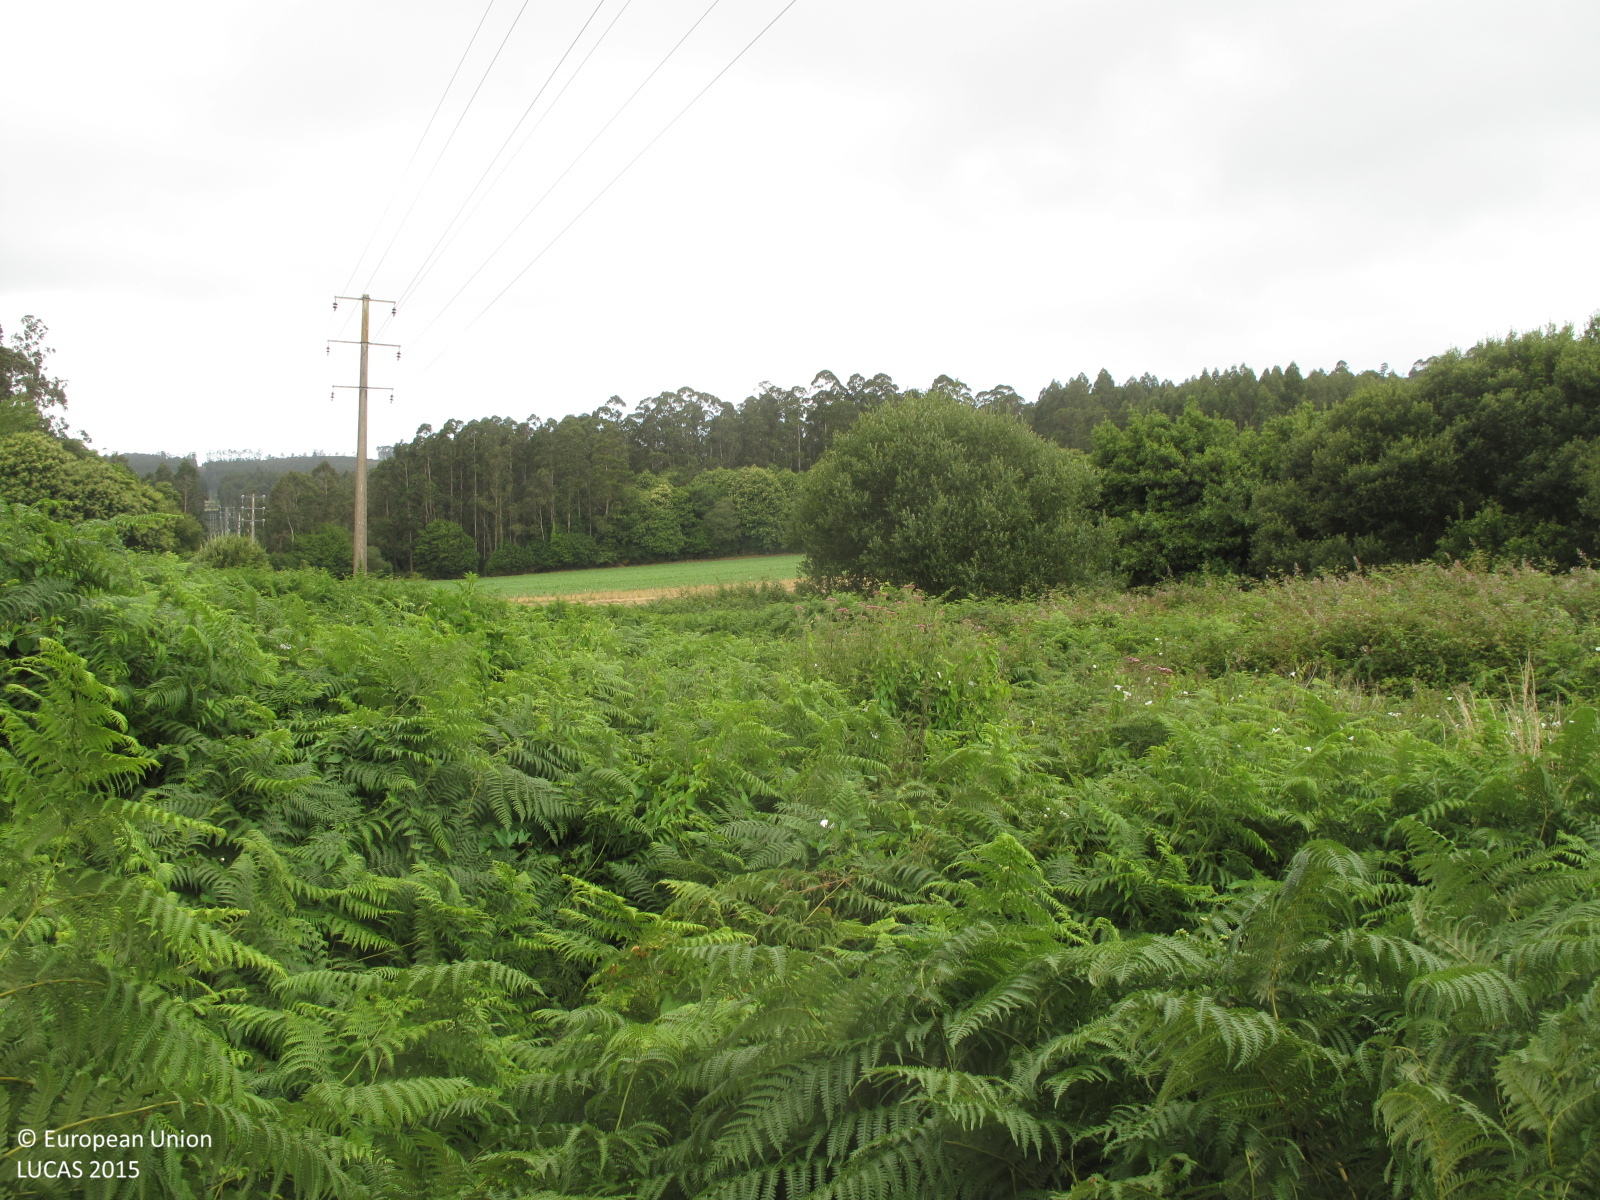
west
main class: Grassland
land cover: Grassland without tree/shrub cover
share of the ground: > 75 %
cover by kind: herbaceous plants 100 %
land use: Abandoned areas
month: July
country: ES
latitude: 43.6091
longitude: -8.1029
